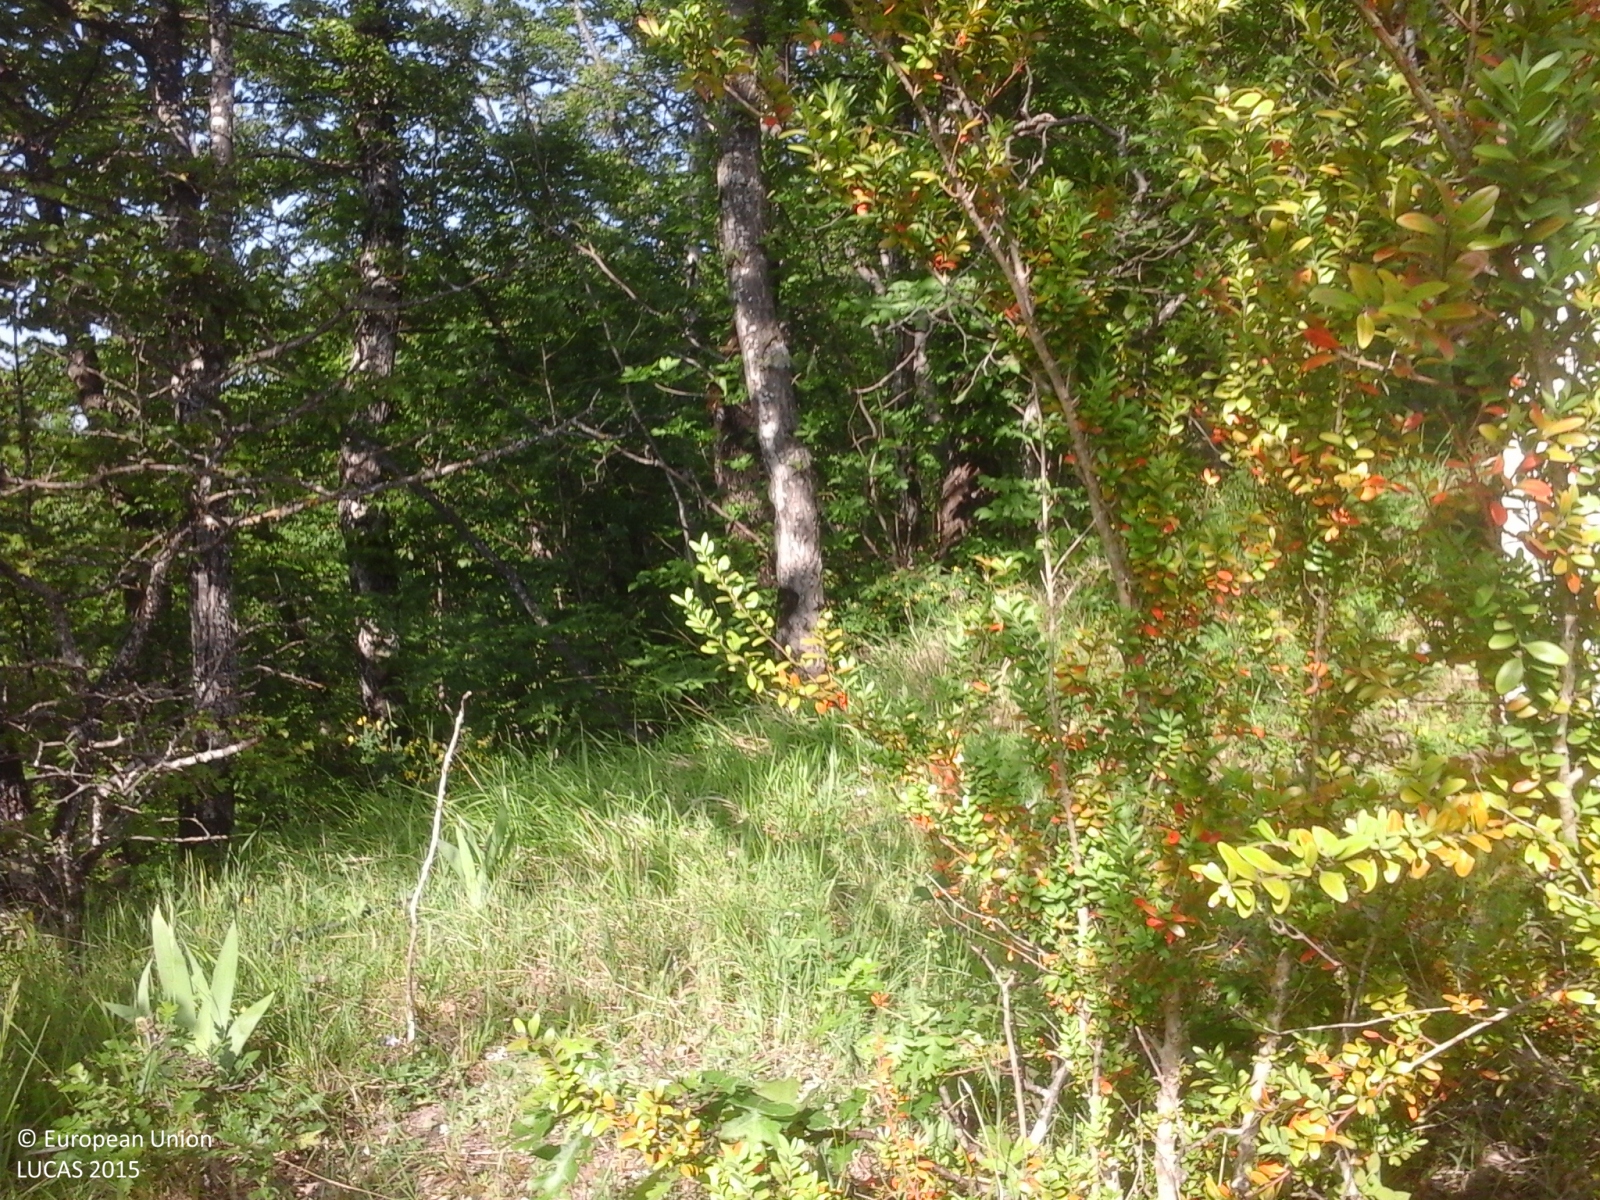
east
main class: Woodland
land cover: Broadleaved woodland
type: mesophytic deciduous forest
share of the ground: > 75 %
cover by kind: broadleaved forest trees 100 %
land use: Forestry
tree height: > 5 m
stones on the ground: 10 - 25 %
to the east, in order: Broadleaved woodland; Grassland without tree/shrub cover; Broadleaved woodland; Electric lines; Grassland without tree/shrub cover; Tracks; Broadleaved woodland; Grassland without tree/shrub cover; Paved roads, cycling and walking lanes; Grassland without tree/shrub cover; Ditches and canals; Lines of trees; Grass margins; Ditches and canals; Lines of trees; Grassland without tree/shrub cover
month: May
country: IT
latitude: 44.1662
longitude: 10.9107
